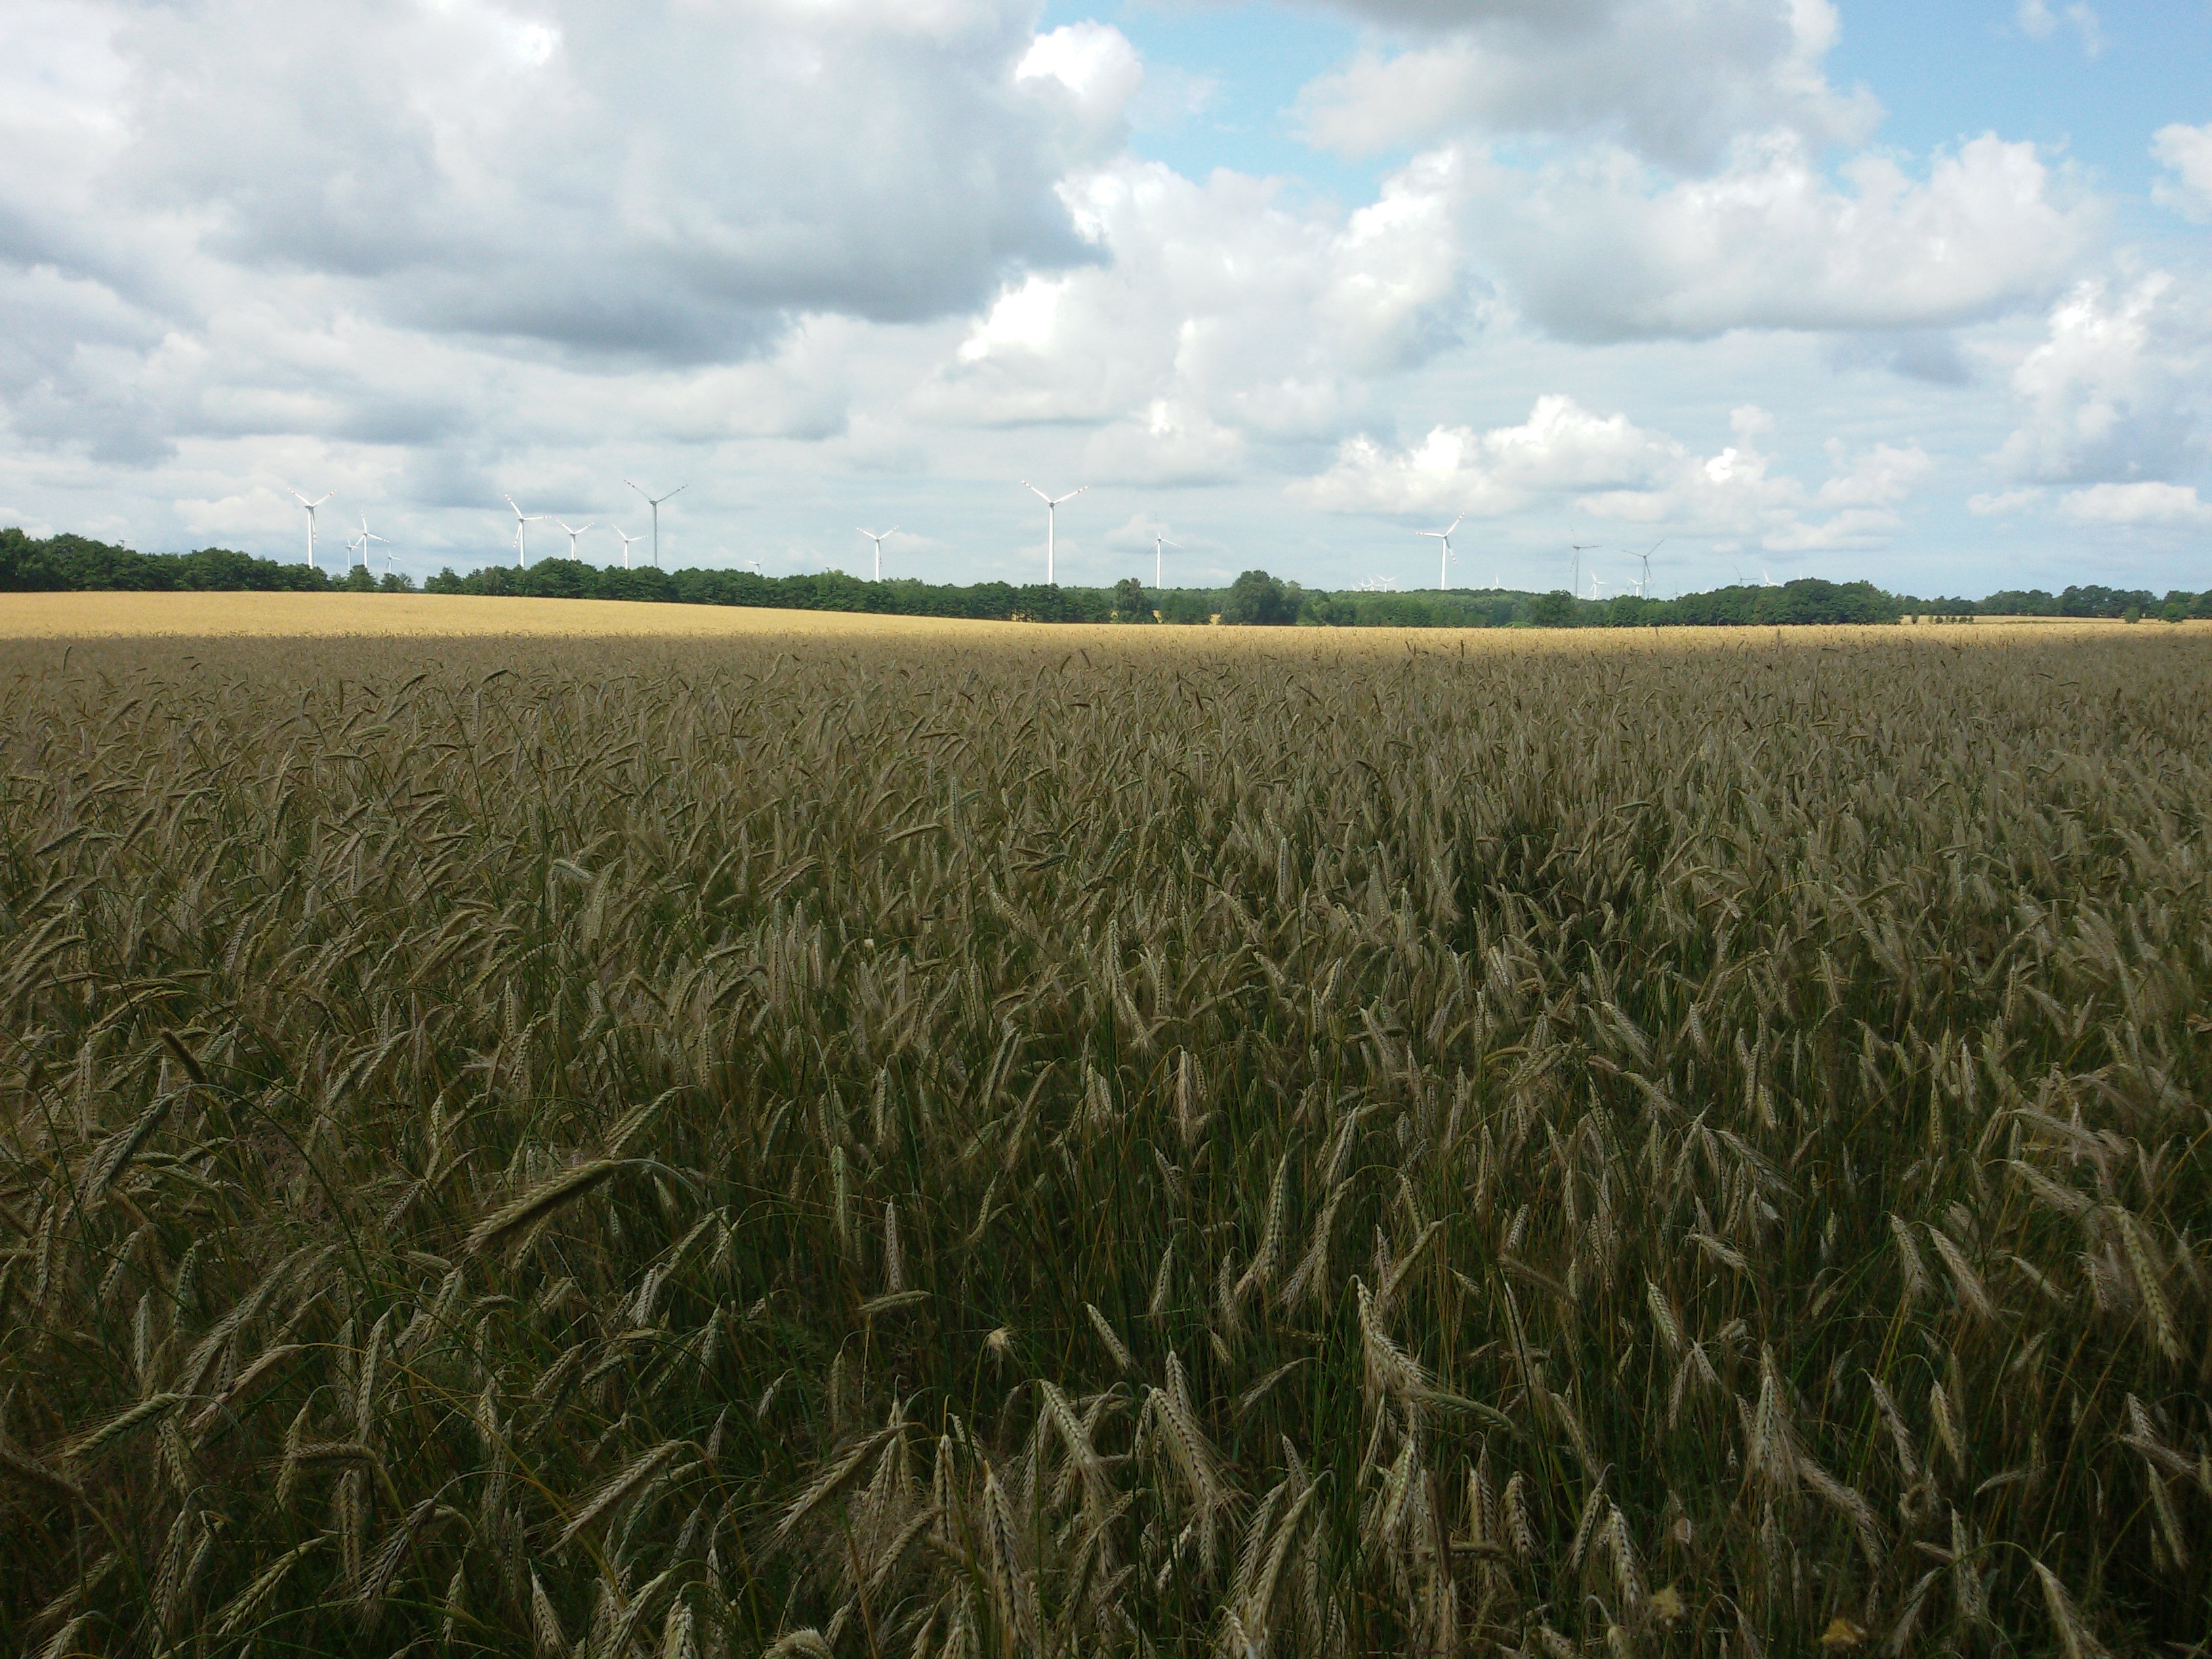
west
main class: Cropland
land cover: Rye
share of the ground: > 75 %
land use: Agriculture (excluding fallow land and kitchen gardens)
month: July
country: PL
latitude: 54.0534
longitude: 15.8543
